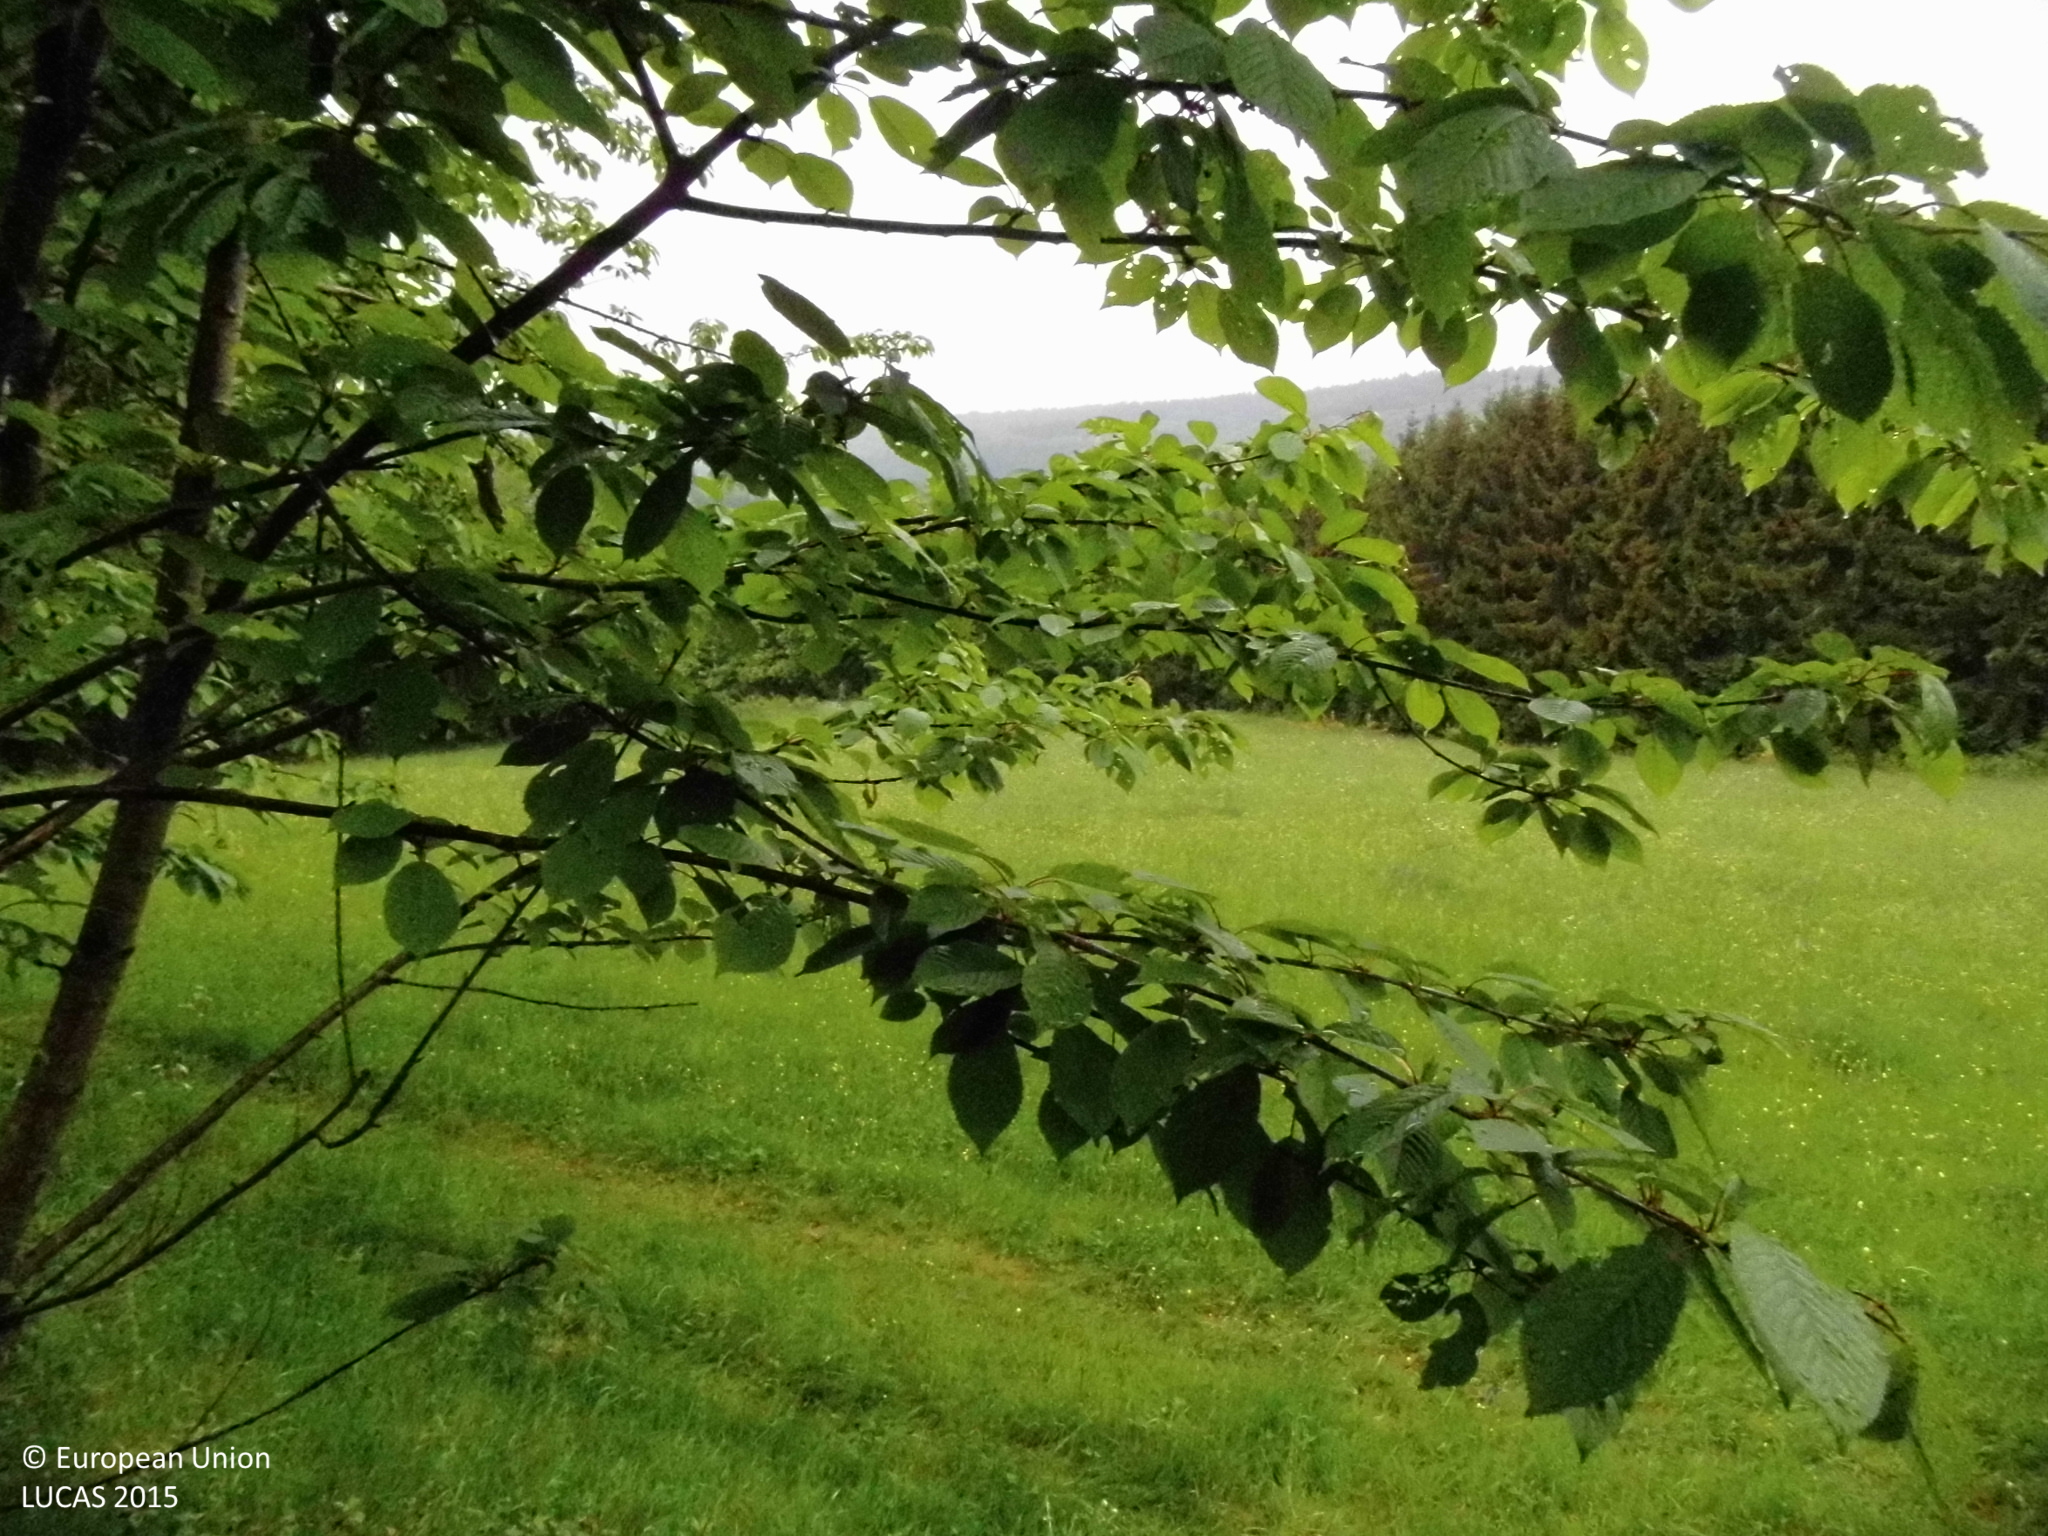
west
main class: Shrubland
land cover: Shrubland with sparse tree cover
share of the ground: > 75 %
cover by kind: herbaceous plants 55 %, shrubs 40 %, broadleaved forest trees 5 %
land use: Semi-natural and natural areas not in use
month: May
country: DE
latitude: 50.6072
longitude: 7.5274
